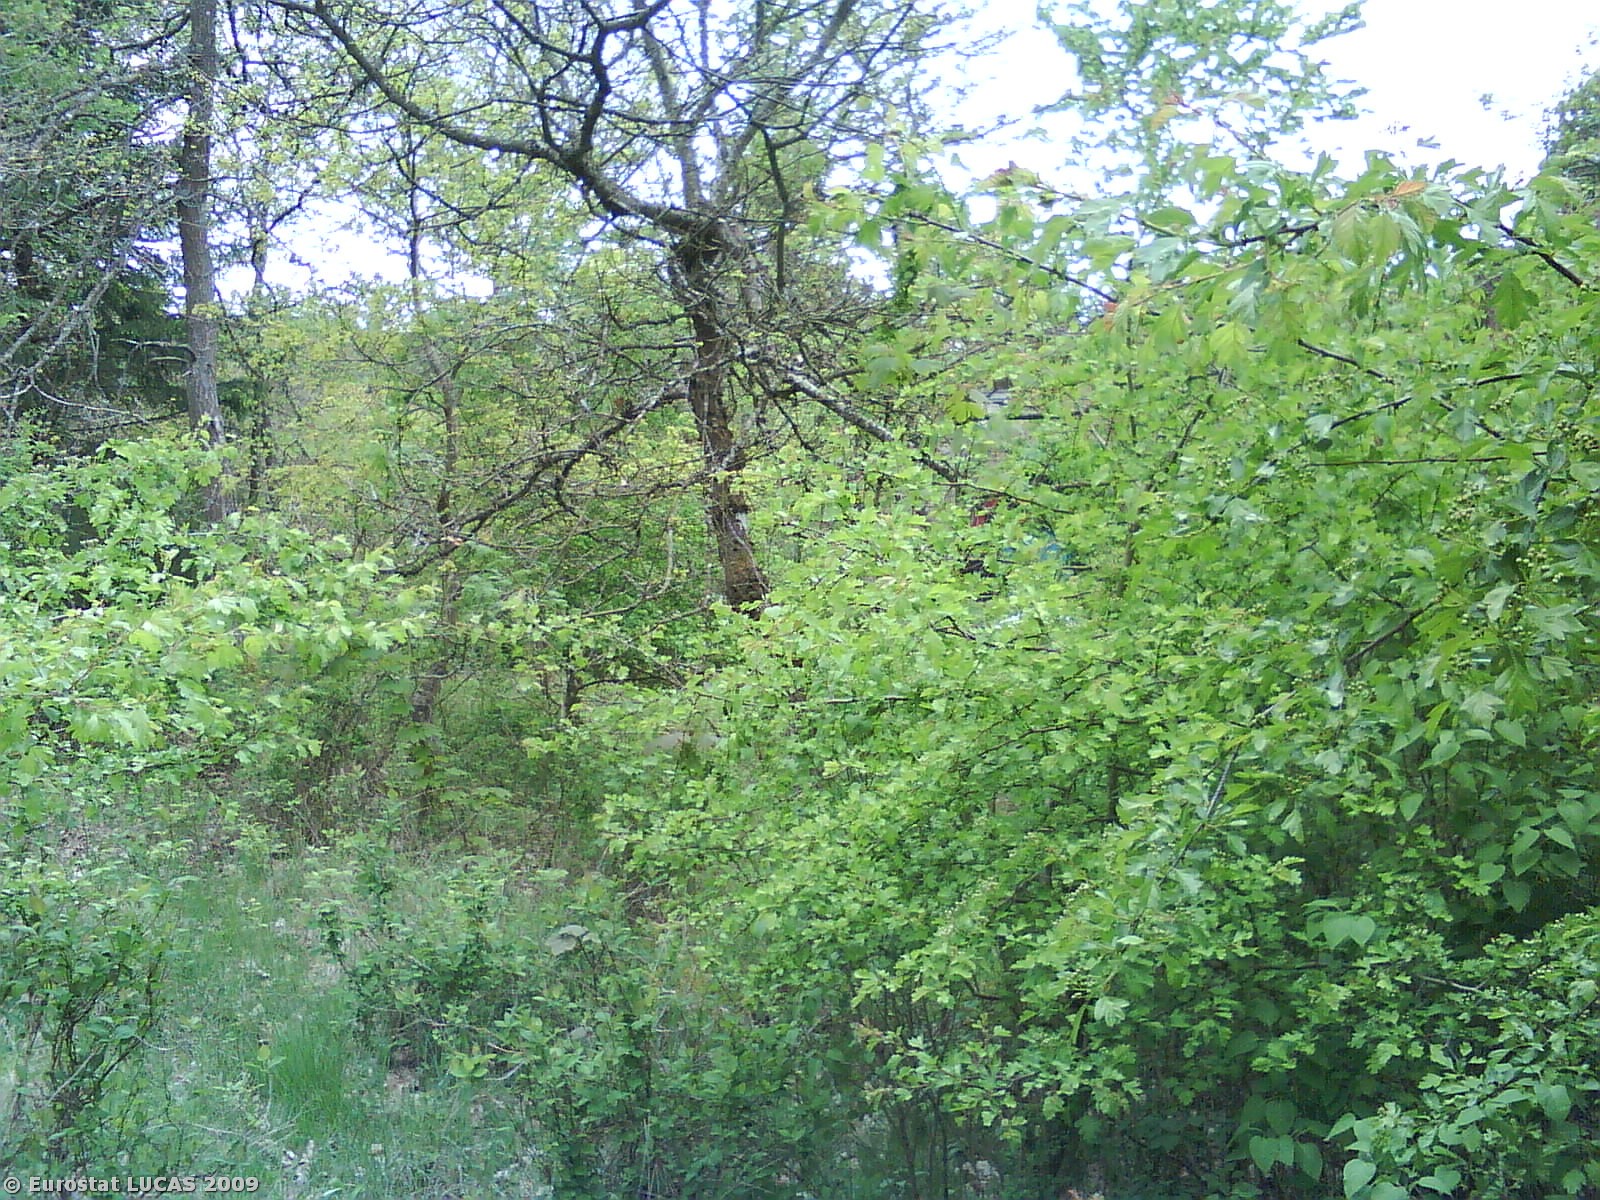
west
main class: Woodland
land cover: Mixed woodland
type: hemiboreal forest and nemoral coniferous forest and mixed broadleaved-coniferous forest
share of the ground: 10 - 25 %
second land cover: Grassland with sparse tree/shrub cover
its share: > 75 %
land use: Forestry
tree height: > 5 m
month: May
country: DK
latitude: 56.4913
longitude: 10.7299
